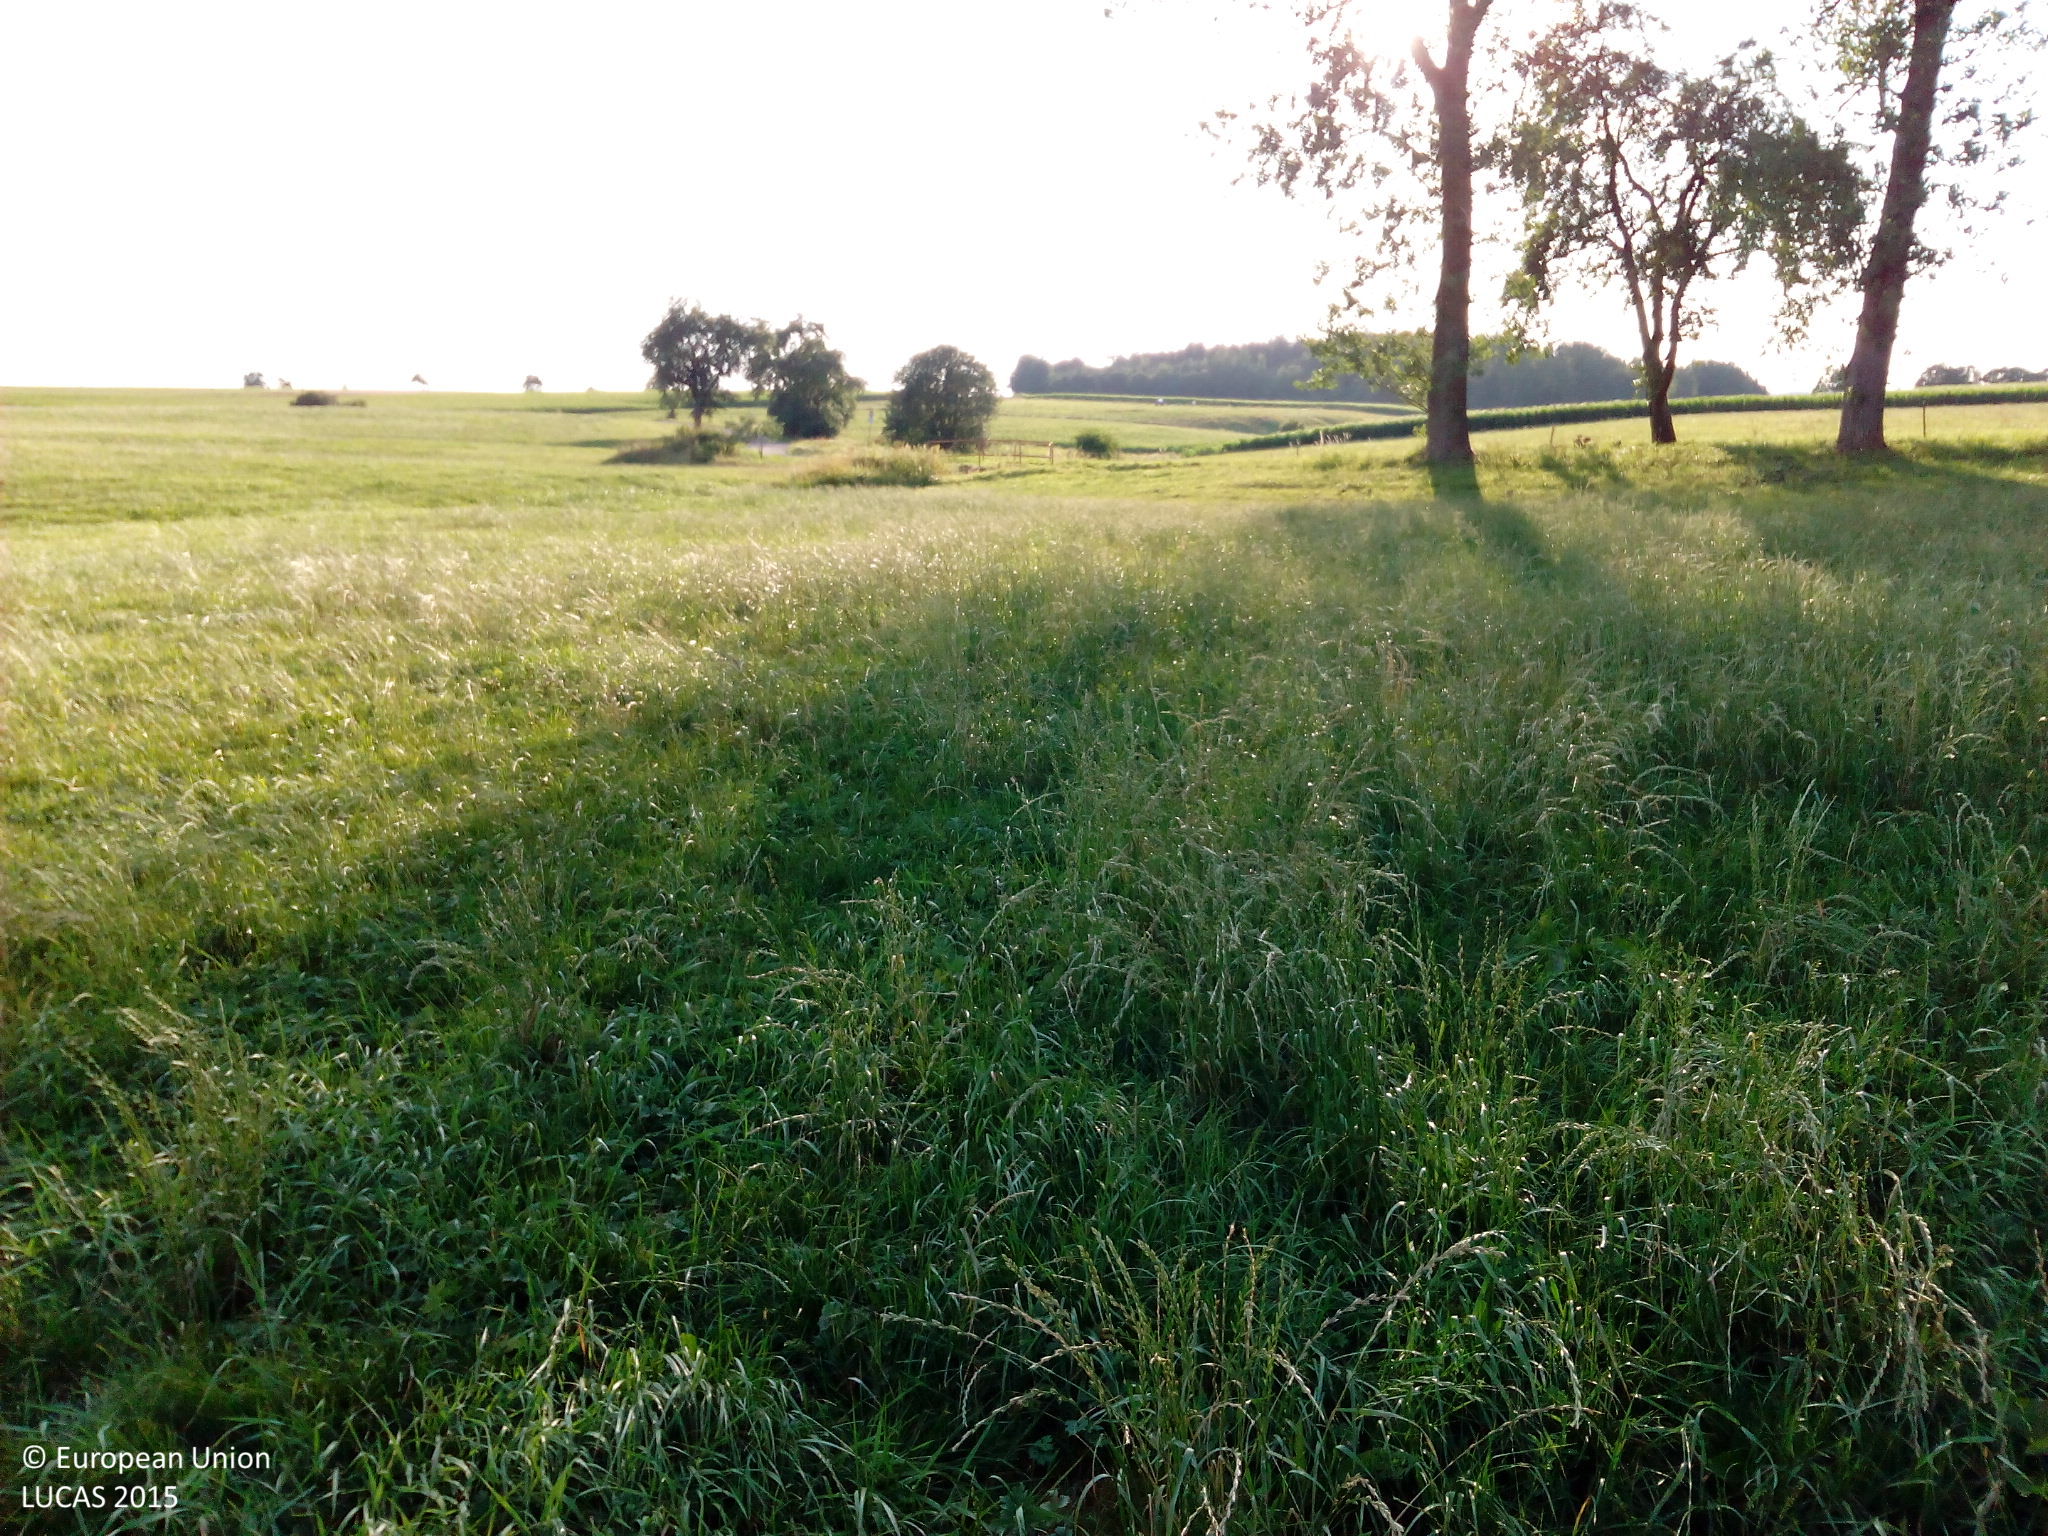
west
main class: Grassland
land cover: Grassland without tree/shrub cover
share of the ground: > 75 %
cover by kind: herbaceous plants 100 %
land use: Agriculture (excluding fallow land and kitchen gardens)
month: July
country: DE
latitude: 48.9429
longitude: 10.2593
